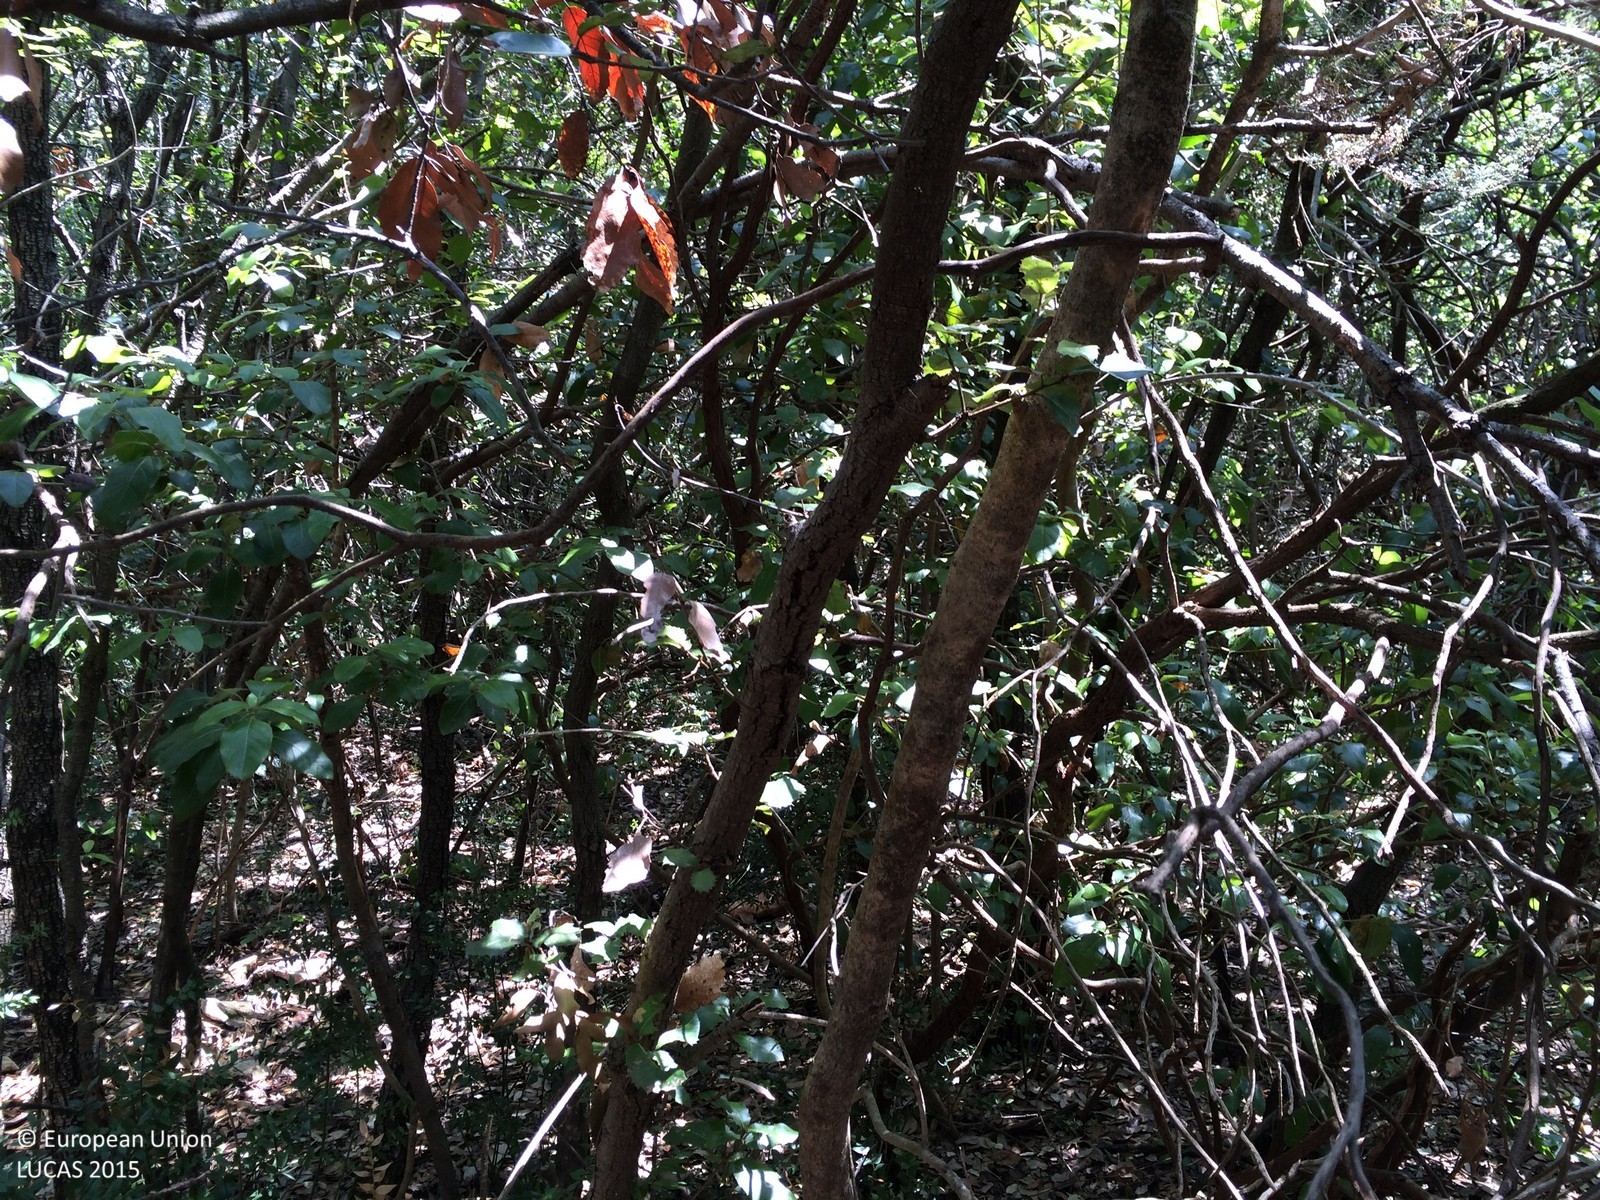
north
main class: Woodland
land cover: Broadleaved woodland
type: broadleaved evergreen forest
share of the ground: > 75 %
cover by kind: broadleaved forest trees 95 %, shrubs 5 %
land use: Semi-natural and natural areas not in use
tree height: > 5 m
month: June
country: HR
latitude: 44.9580
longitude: 14.0380
